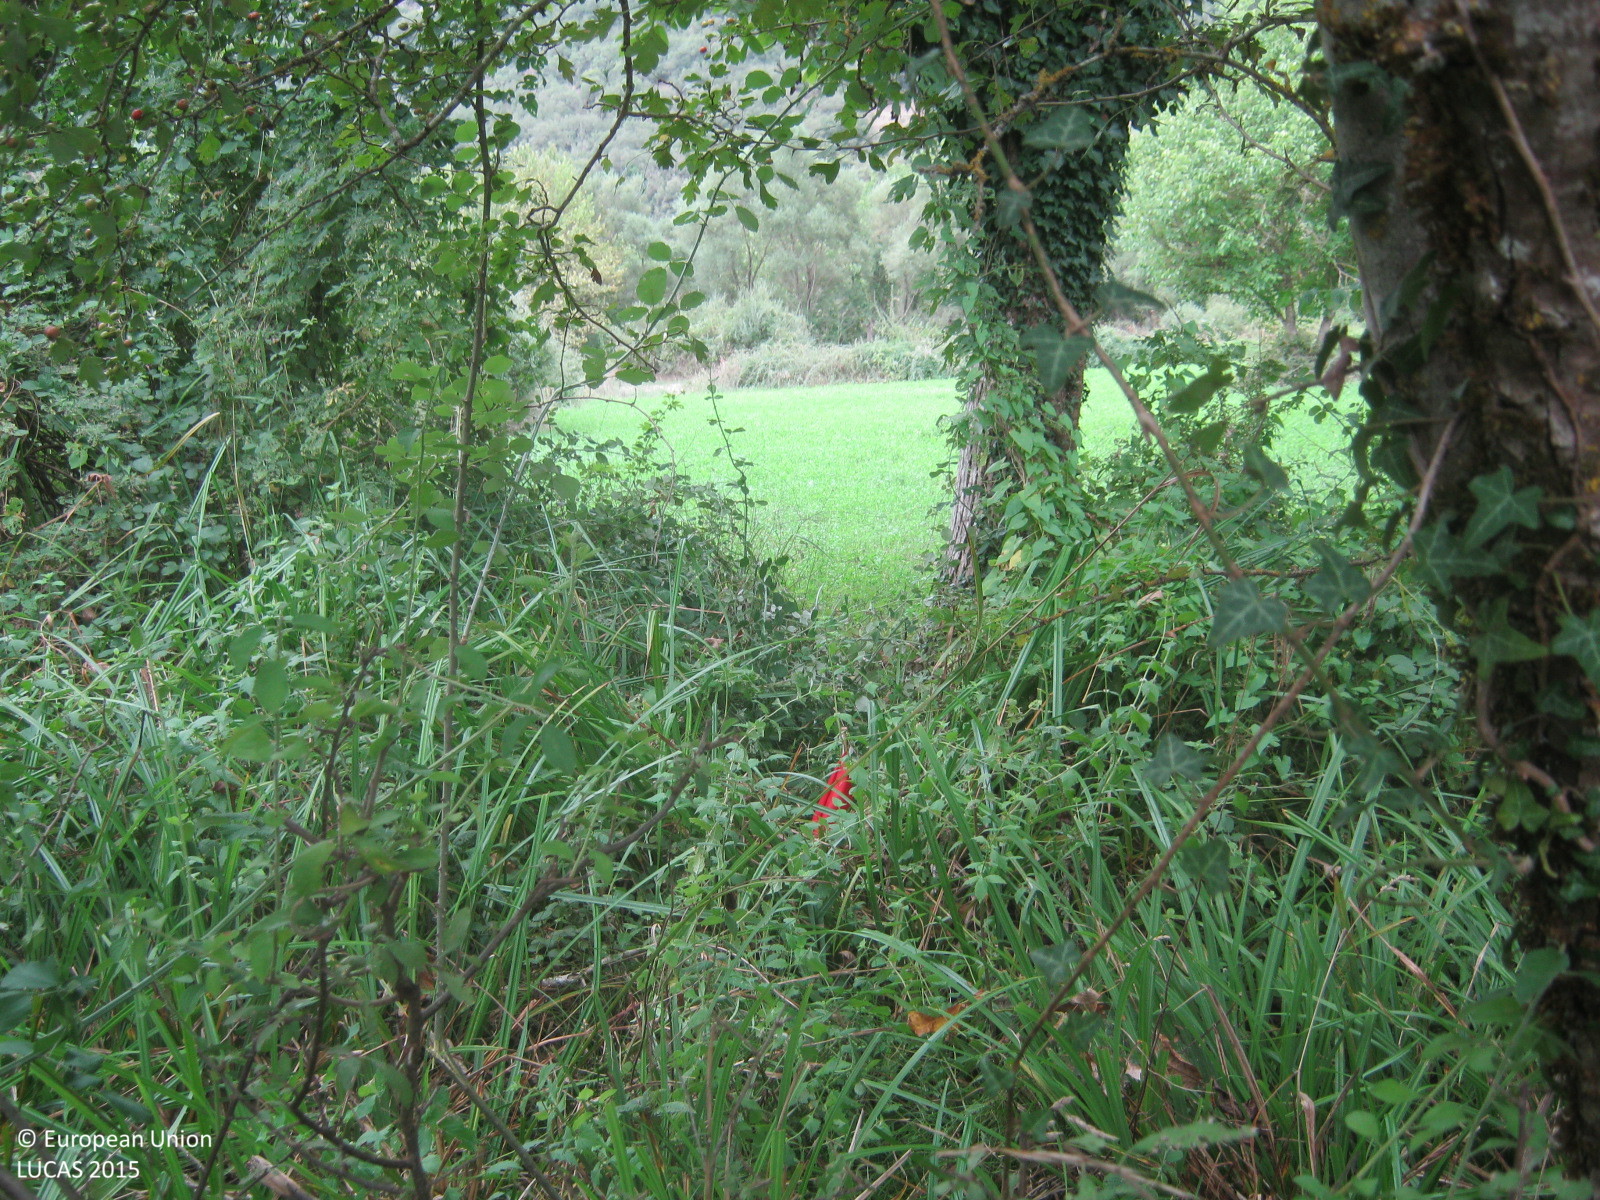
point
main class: Woodland
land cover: Broadleaved woodland
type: thermophilous deciduous forest
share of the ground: 50 - 75 %
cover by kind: broadleaved forest trees 70 %, herbaceous plants 30 %
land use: Semi-natural and natural areas not in use
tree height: > 5 m
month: September
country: GR
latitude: 37.8878
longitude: 22.0976
